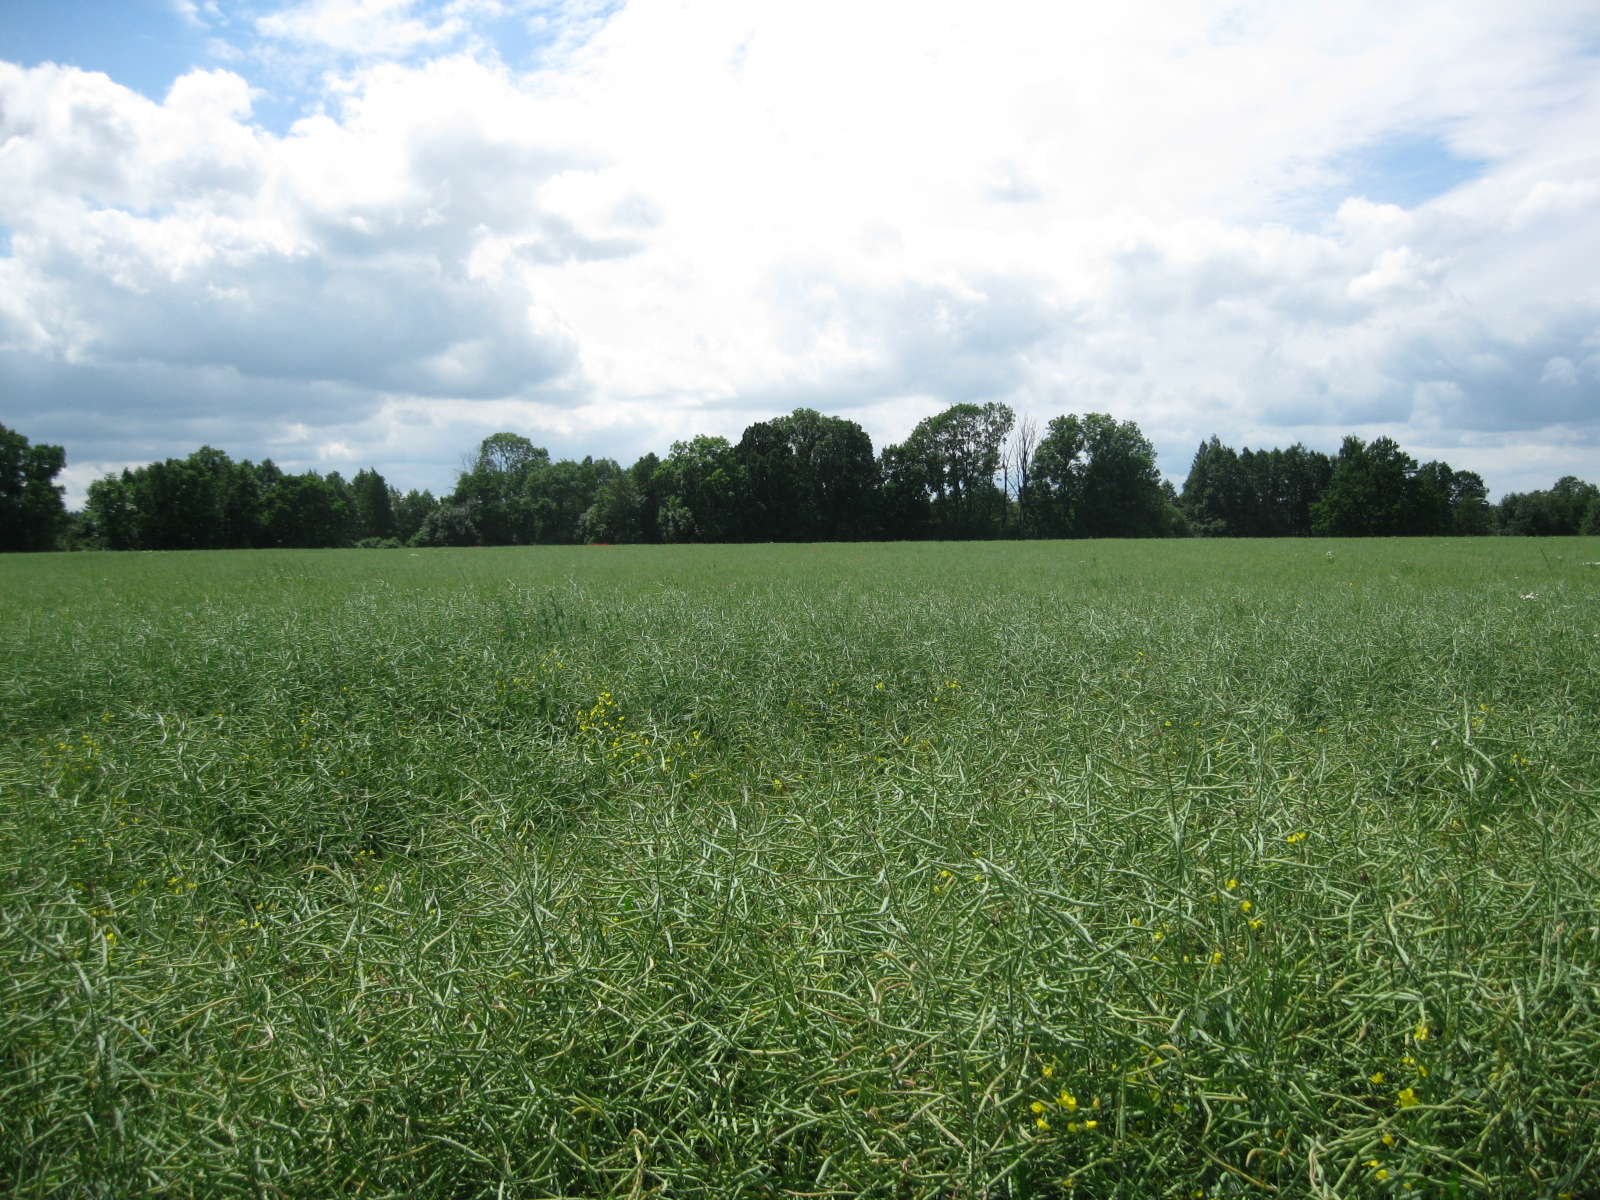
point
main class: Cropland
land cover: Rape and turnip rape
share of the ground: > 75 %
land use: Agriculture (excluding fallow land and kitchen gardens)
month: June
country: LT
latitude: 55.5760
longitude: 24.1937
